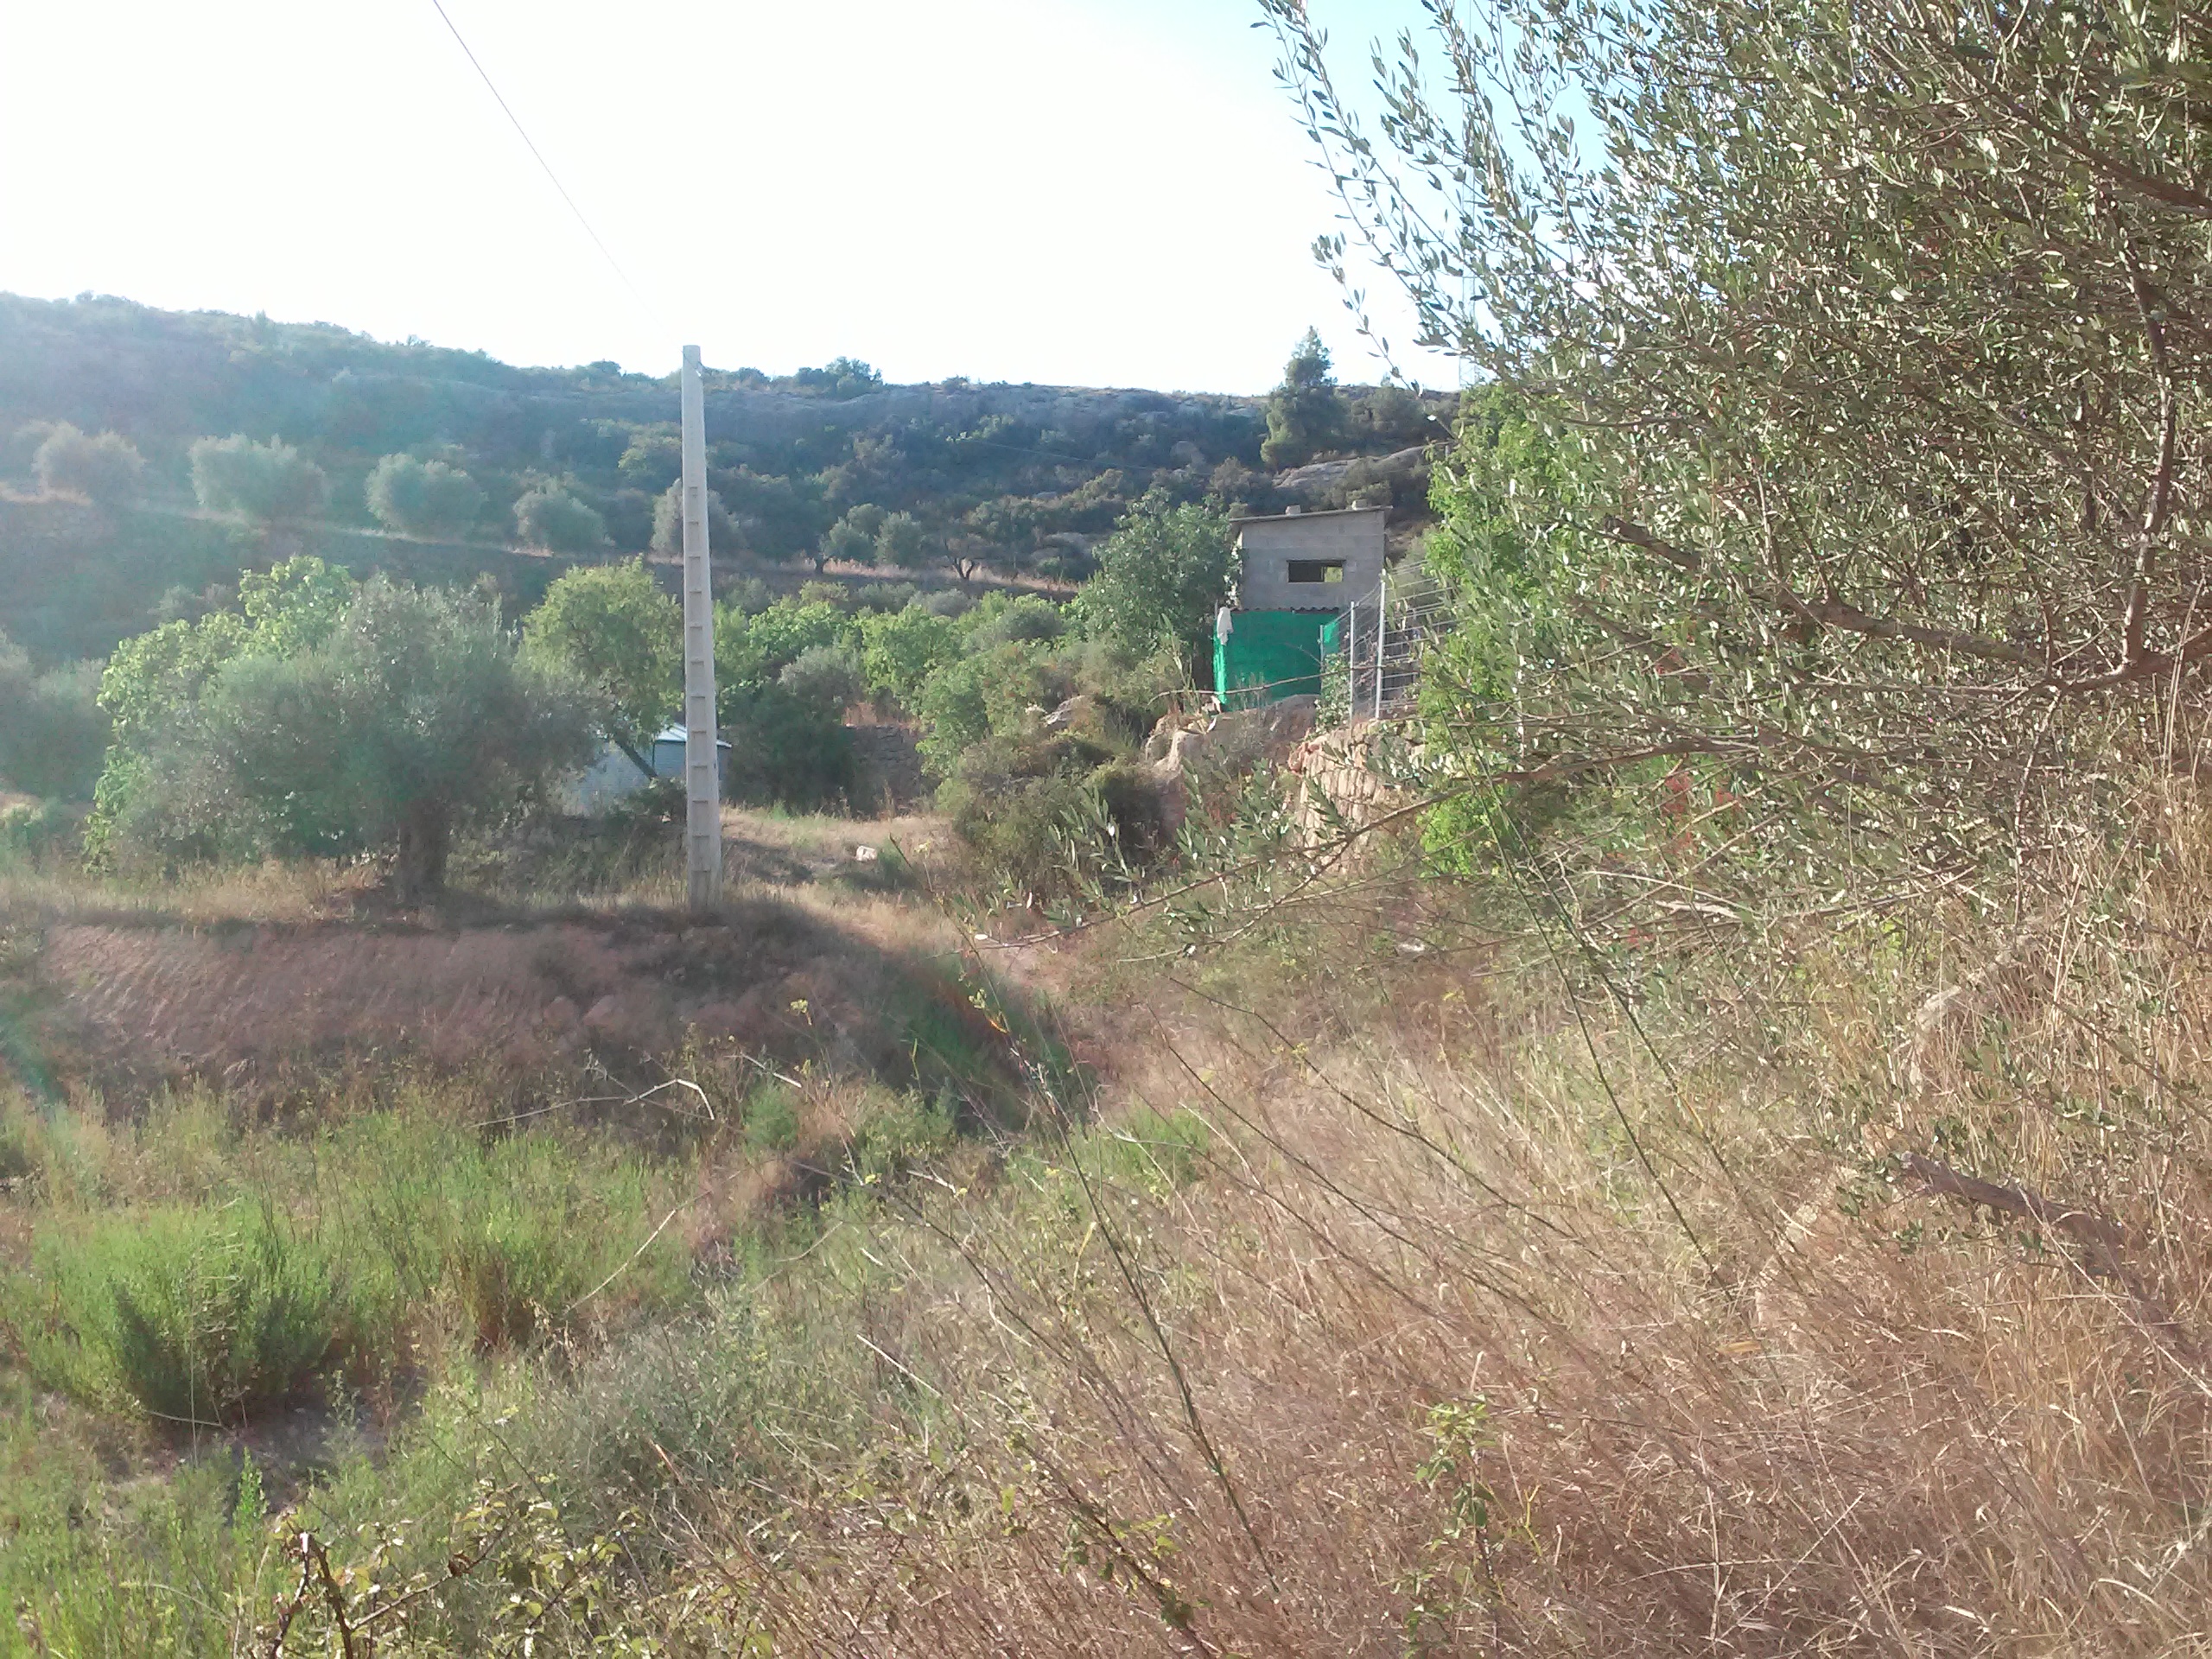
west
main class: Shrubland
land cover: Shrubland with sparse tree cover
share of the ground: > 75 %
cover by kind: shrubs 55 %, herbaceous plants 30 %, consolidated bare surface 10 %, broadleaved forest trees 5 %
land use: Semi-natural and natural areas not in use
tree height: < 5 m
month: August
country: ES
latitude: 41.3778
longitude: 0.7713
